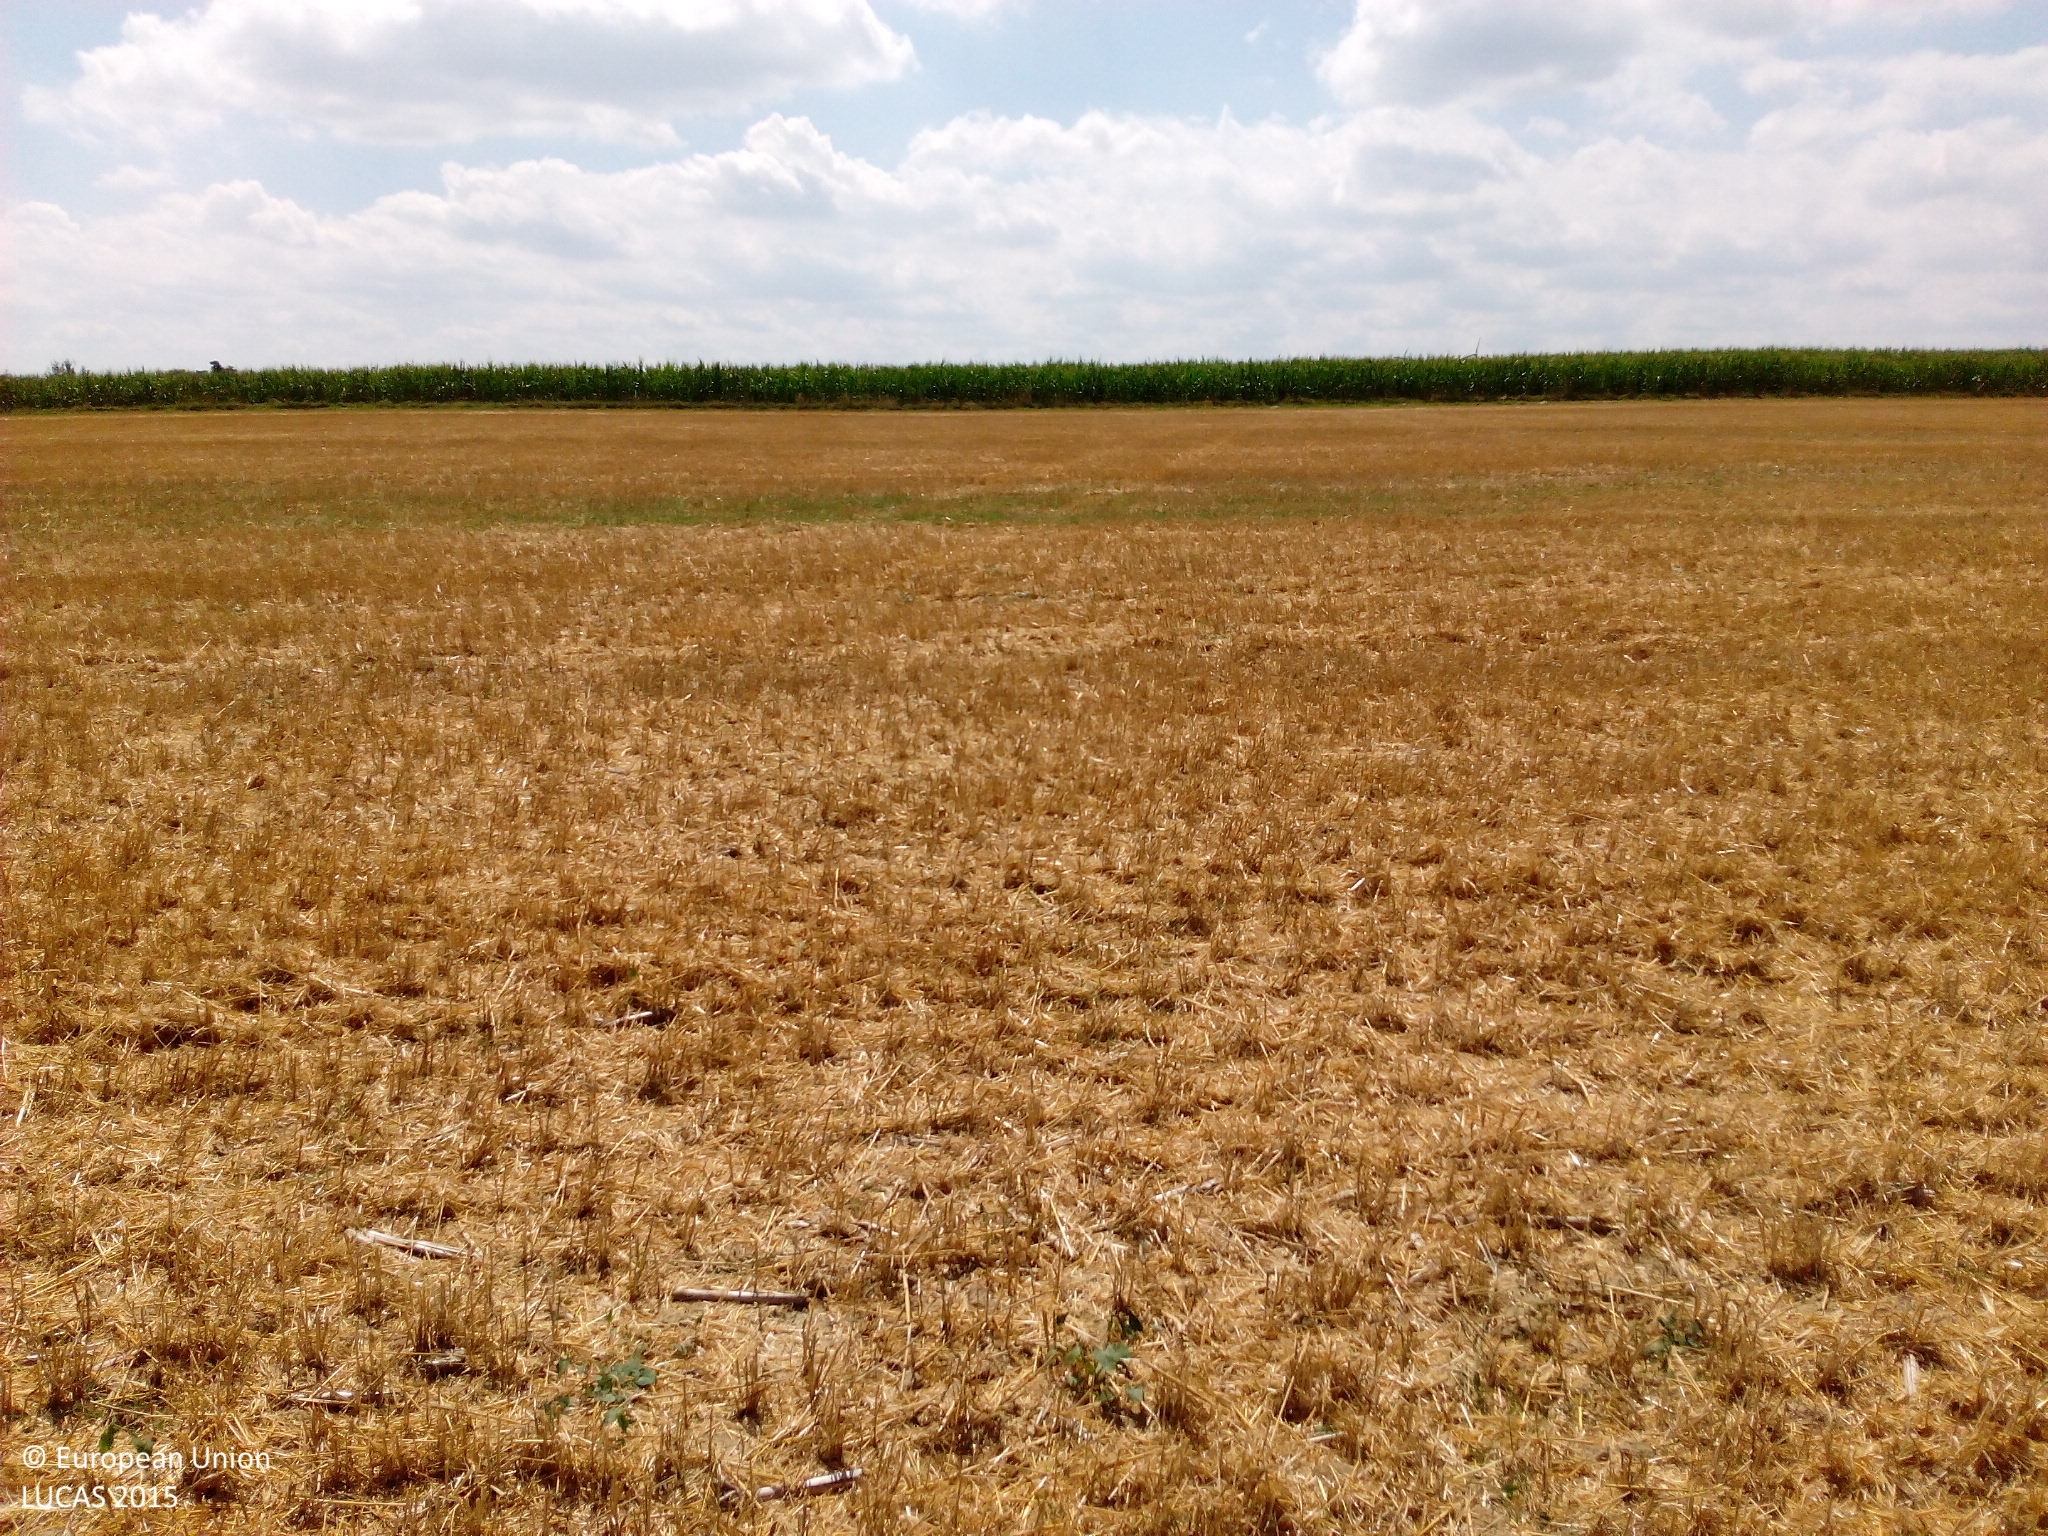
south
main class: Cropland
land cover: Common wheat
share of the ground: < 10 %
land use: Agriculture (excluding fallow land and kitchen gardens)
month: August
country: DE
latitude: 48.9788
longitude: 10.3141
